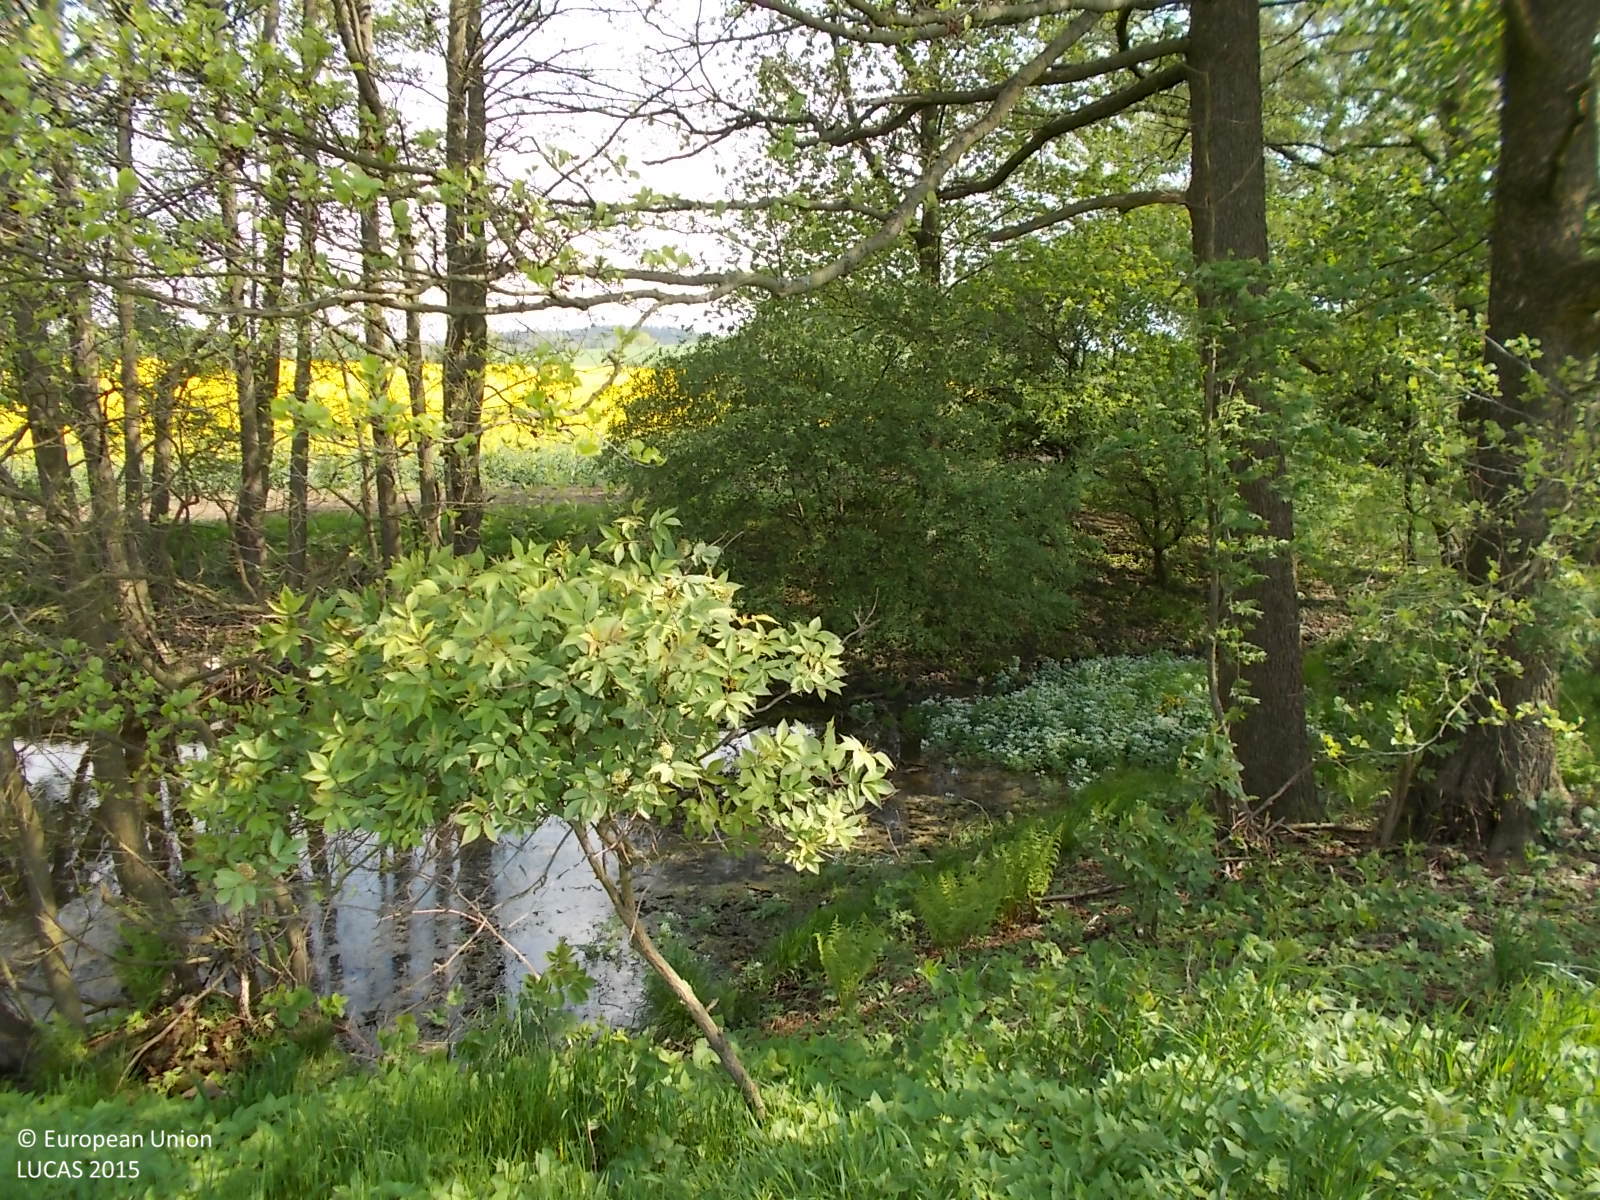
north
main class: Woodland
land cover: Broadleaved woodland
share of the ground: > 75 %
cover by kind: broadleaved forest trees 80 %, herbaceous plants 20 %
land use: Semi-natural and natural areas not in use
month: May
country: CZ
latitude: 49.6521
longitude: 15.5583
